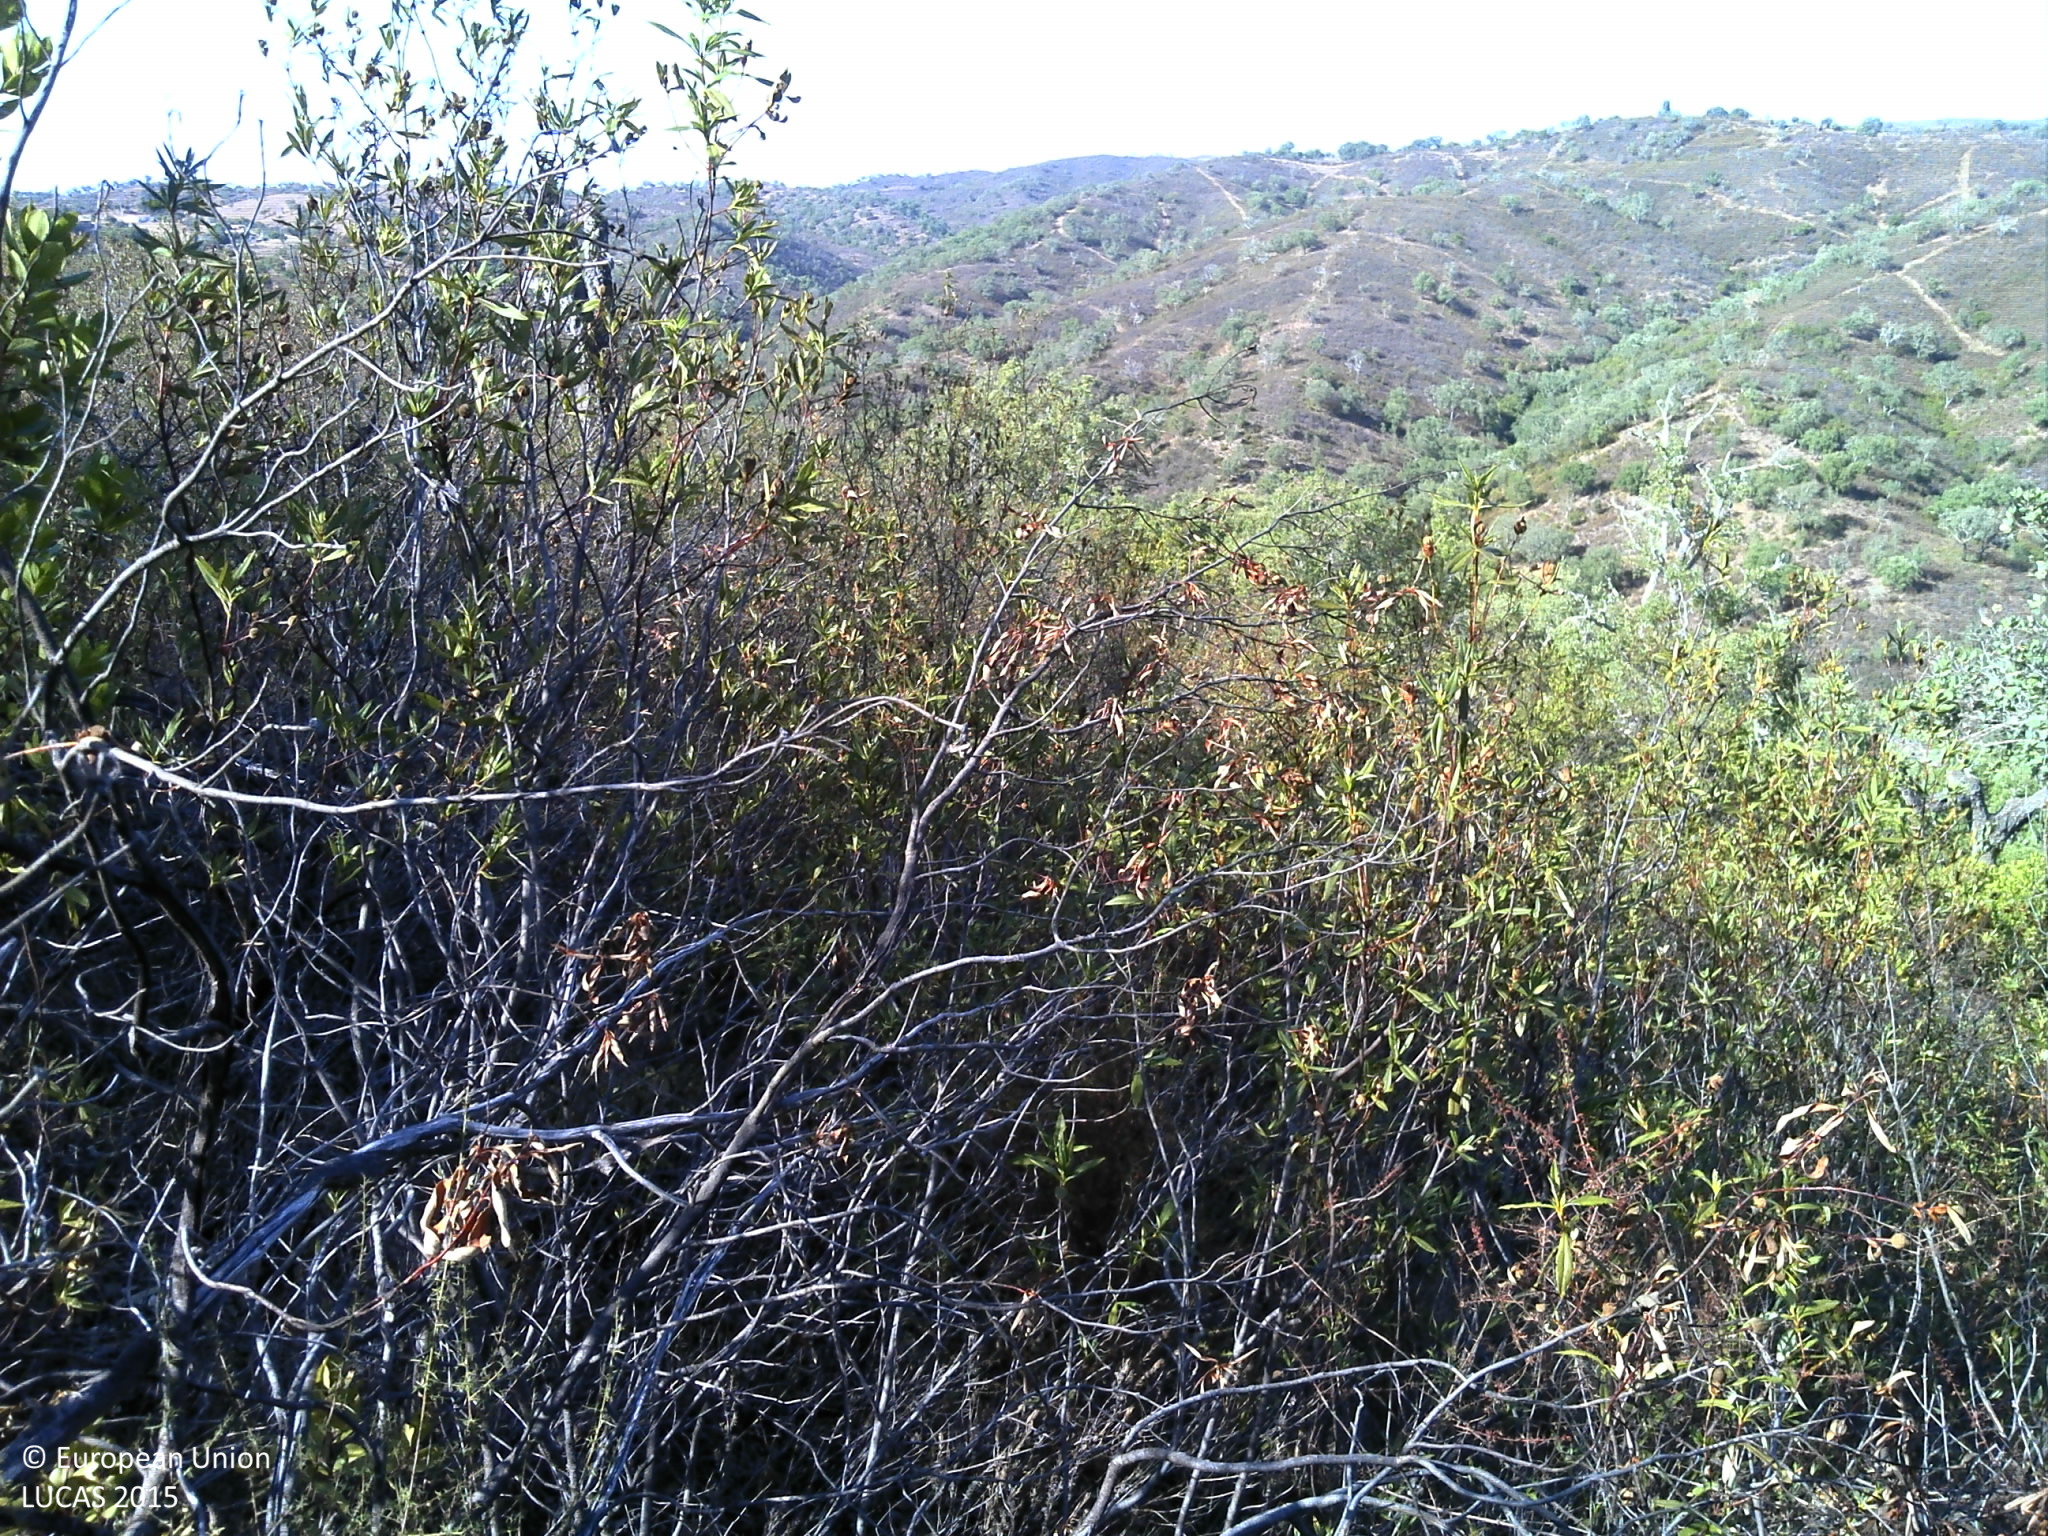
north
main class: Woodland
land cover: Broadleaved woodland
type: broadleaved evergreen forest
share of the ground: 50 - 75 %
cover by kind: broadleaved forest trees 50 %, shrubs 40 %, unconsolidated bare surface 10 %
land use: Forestry
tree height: > 5 m
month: September
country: PT
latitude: 37.4367
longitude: -8.2089
